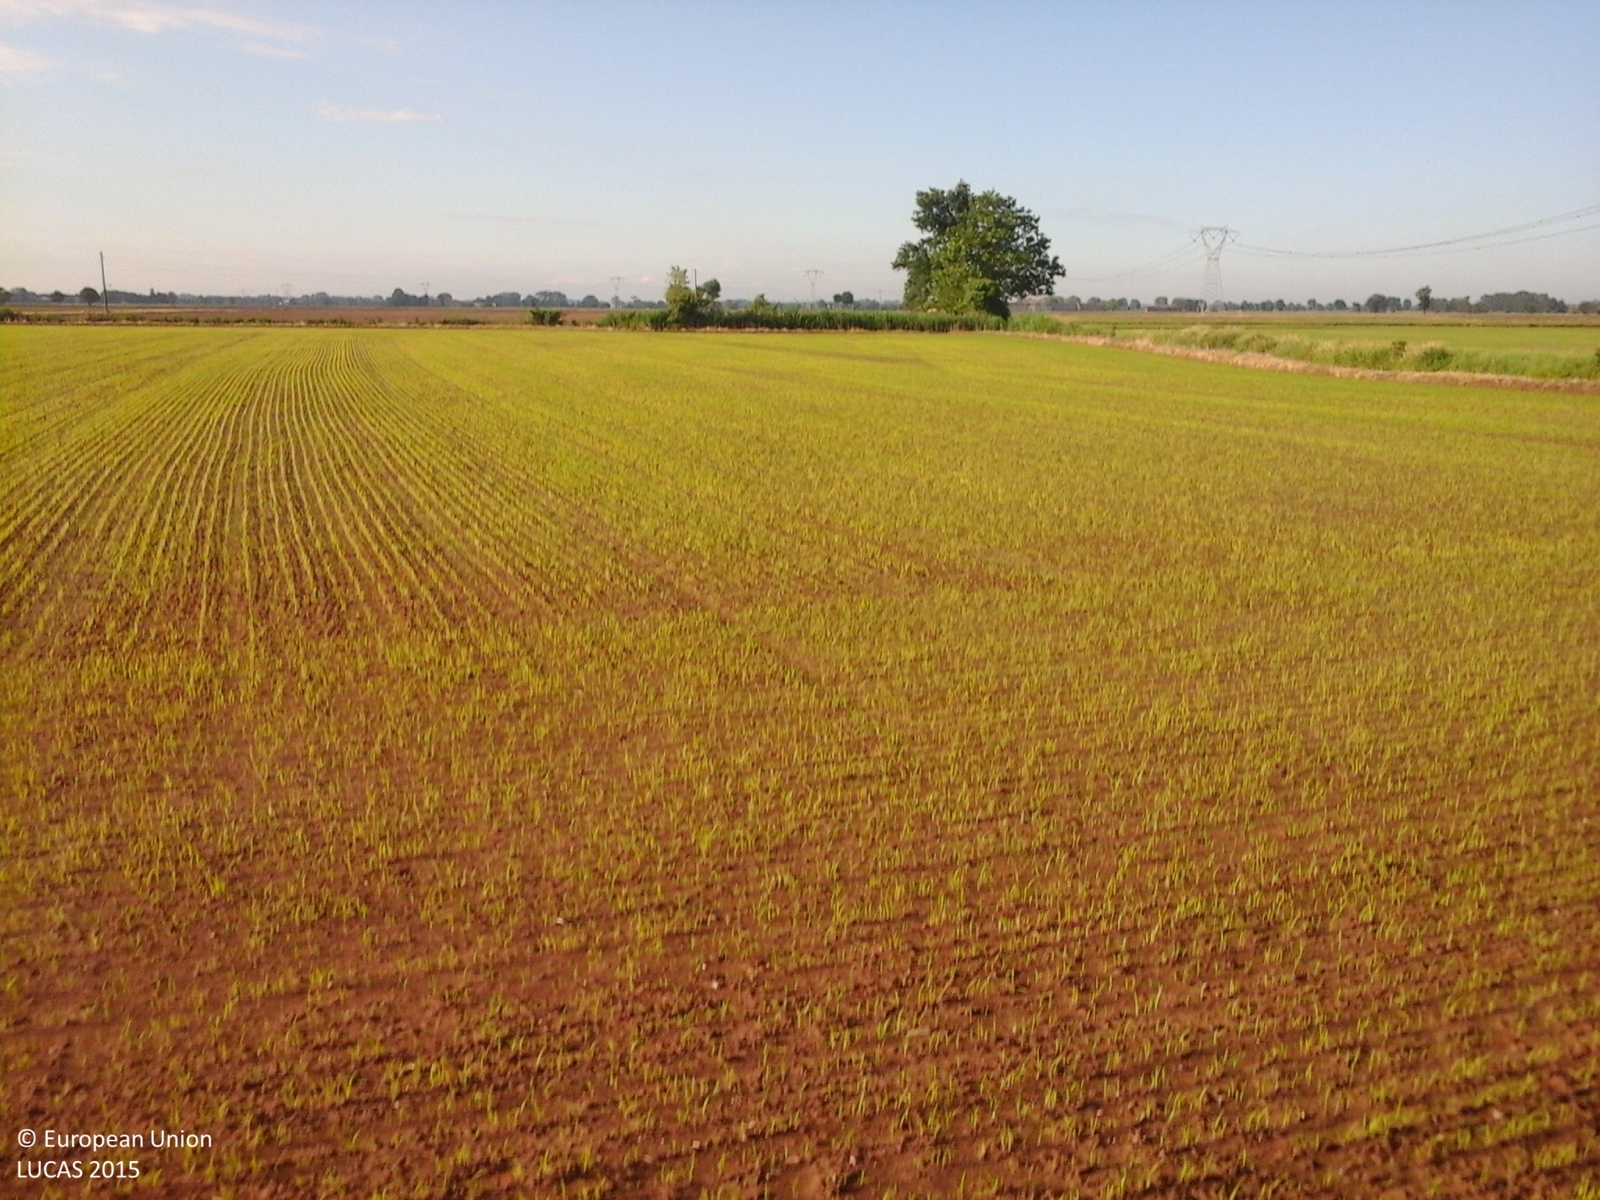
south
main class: Cropland
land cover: Rice
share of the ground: 10 - 25 %
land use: Agriculture (excluding fallow land and kitchen gardens)
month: May
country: IT
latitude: 45.3744
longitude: 9.0950
